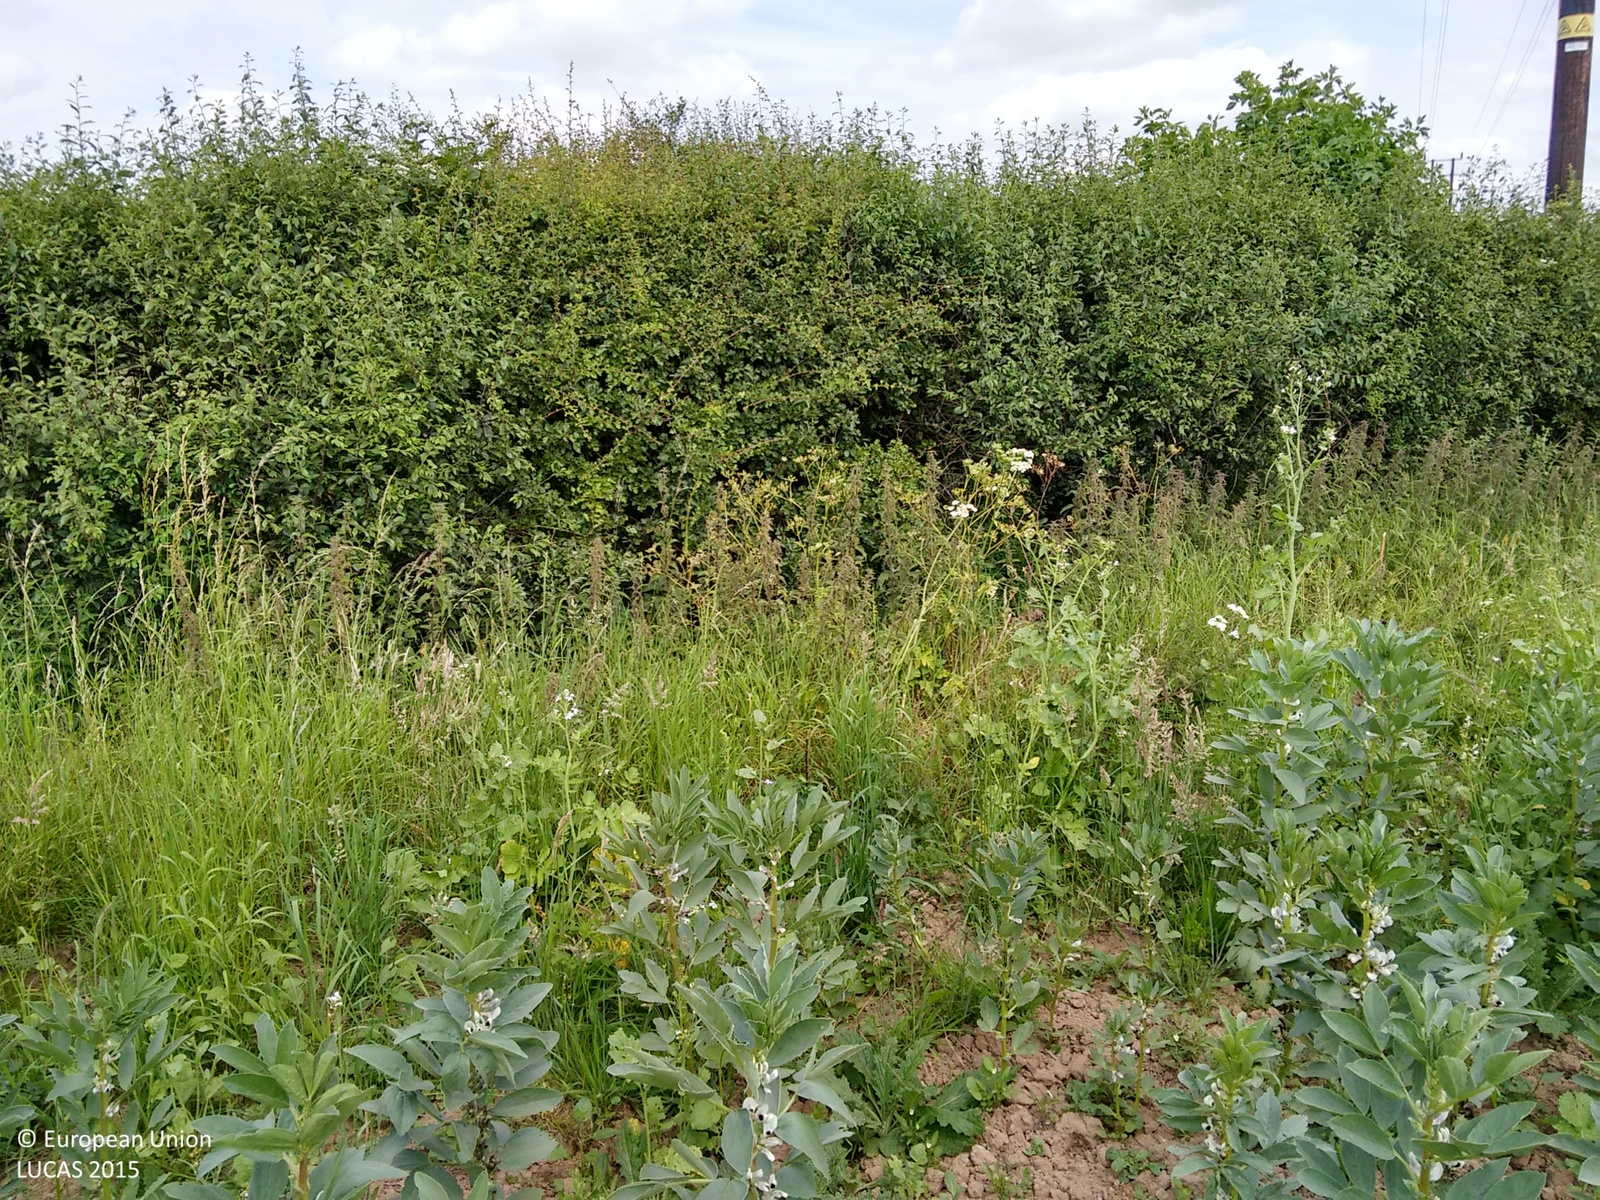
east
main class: Cropland
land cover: Dry pulses
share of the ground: > 75 %
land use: Agriculture (excluding fallow land and kitchen gardens)
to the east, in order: Dry pulses; Electric lines; Dry pulses; Grass margins; Ditches and canals; Managed hedges; Grass margins; Common wheat
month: June
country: GB
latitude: 52.9959
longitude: -0.9343
